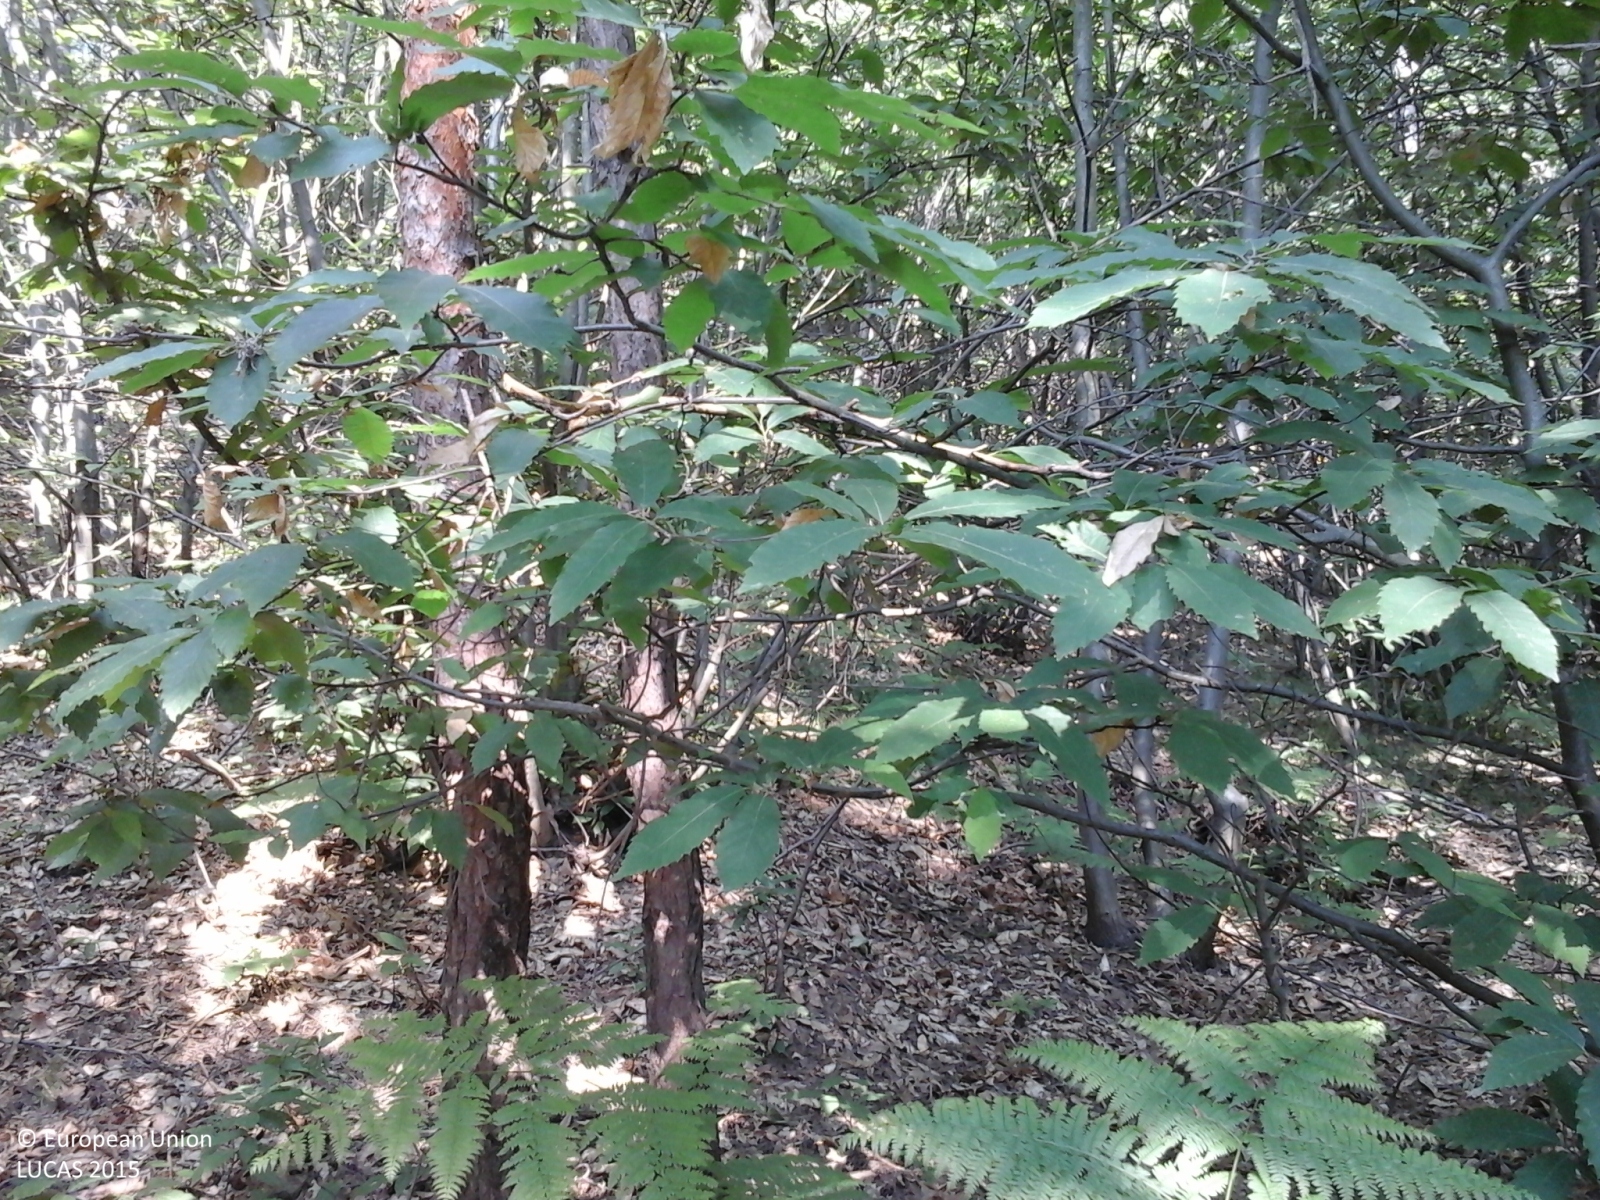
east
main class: Woodland
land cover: Broadleaved woodland
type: thermophilous deciduous forest
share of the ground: > 75 %
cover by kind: broadleaved forest trees 80 %, shrubs 20 %
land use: Forestry
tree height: > 5 m
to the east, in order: Broadleaved woodland; Grassland without tree/shrub cover; Electric lines; Grassland without tree/shrub cover; Broadleaved woodland
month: June
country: IT
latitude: 44.5559
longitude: 8.4800
